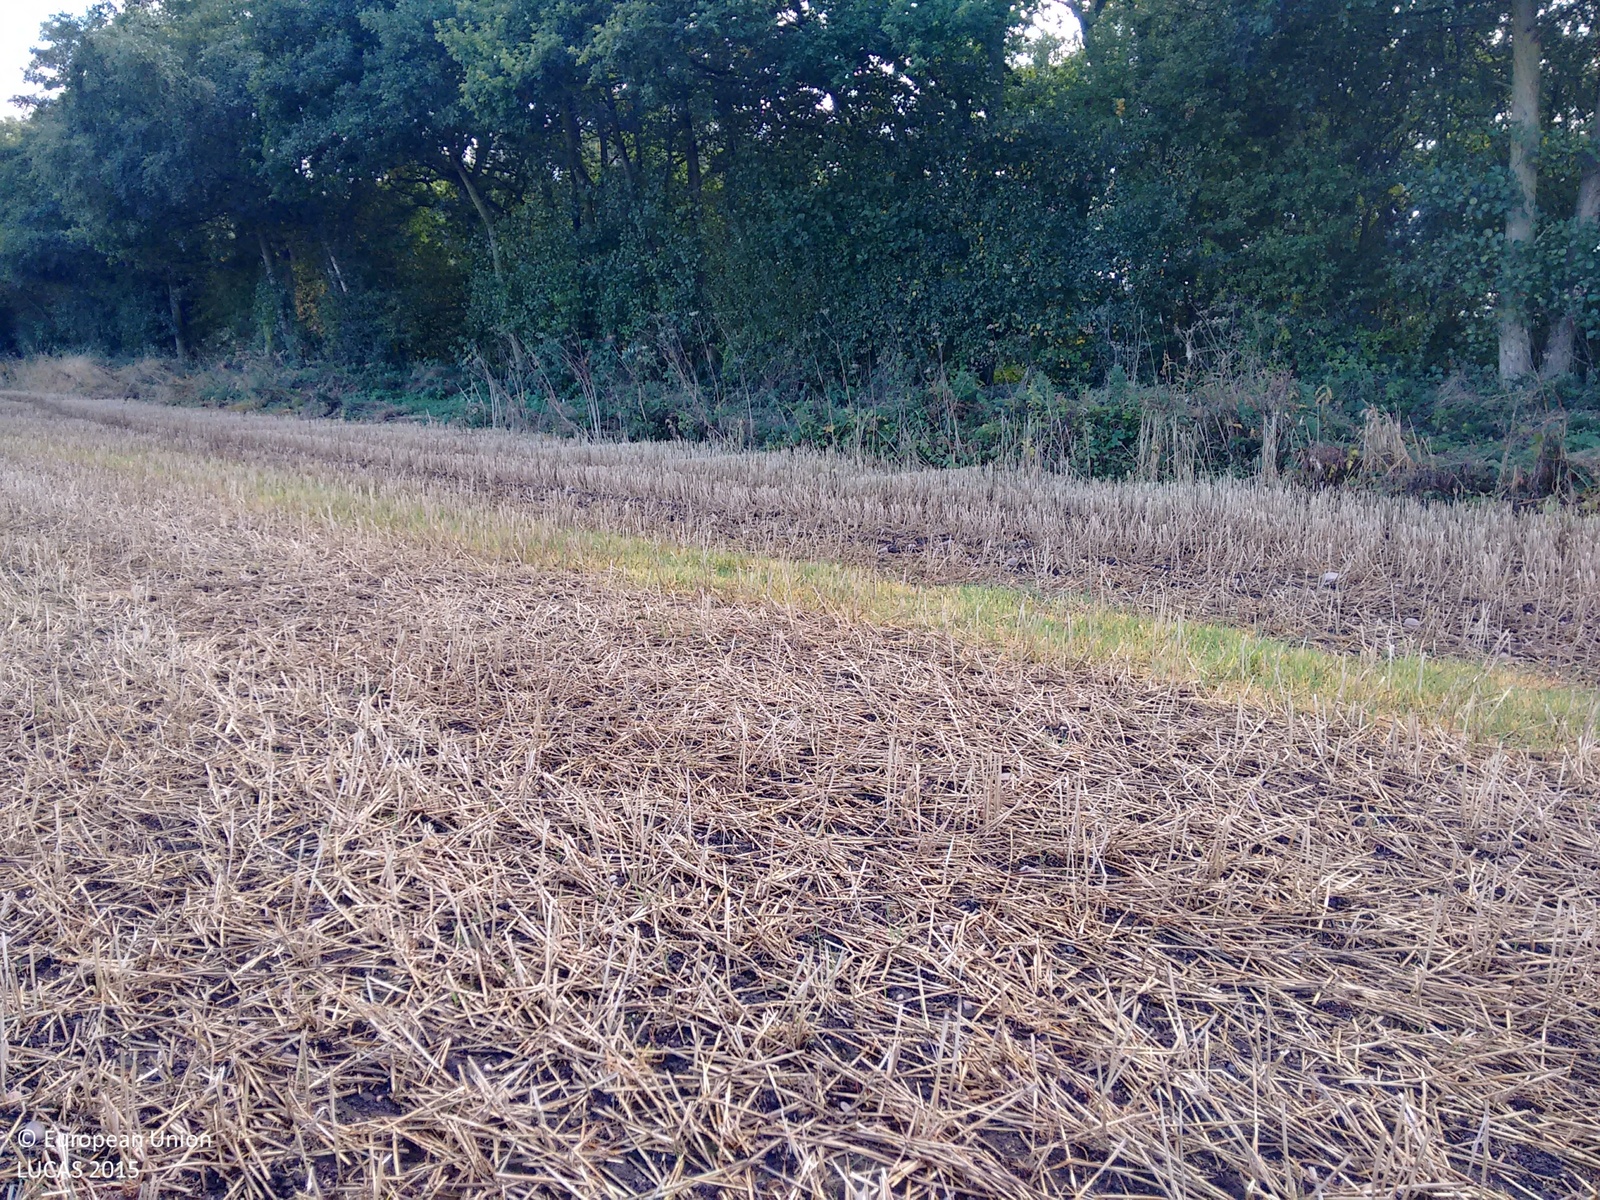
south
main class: Cropland
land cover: Common wheat
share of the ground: 25 - 50 %
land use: Agriculture (excluding fallow land and kitchen gardens)
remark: Harvested field
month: September
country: GB
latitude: 52.7289
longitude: -1.8278
